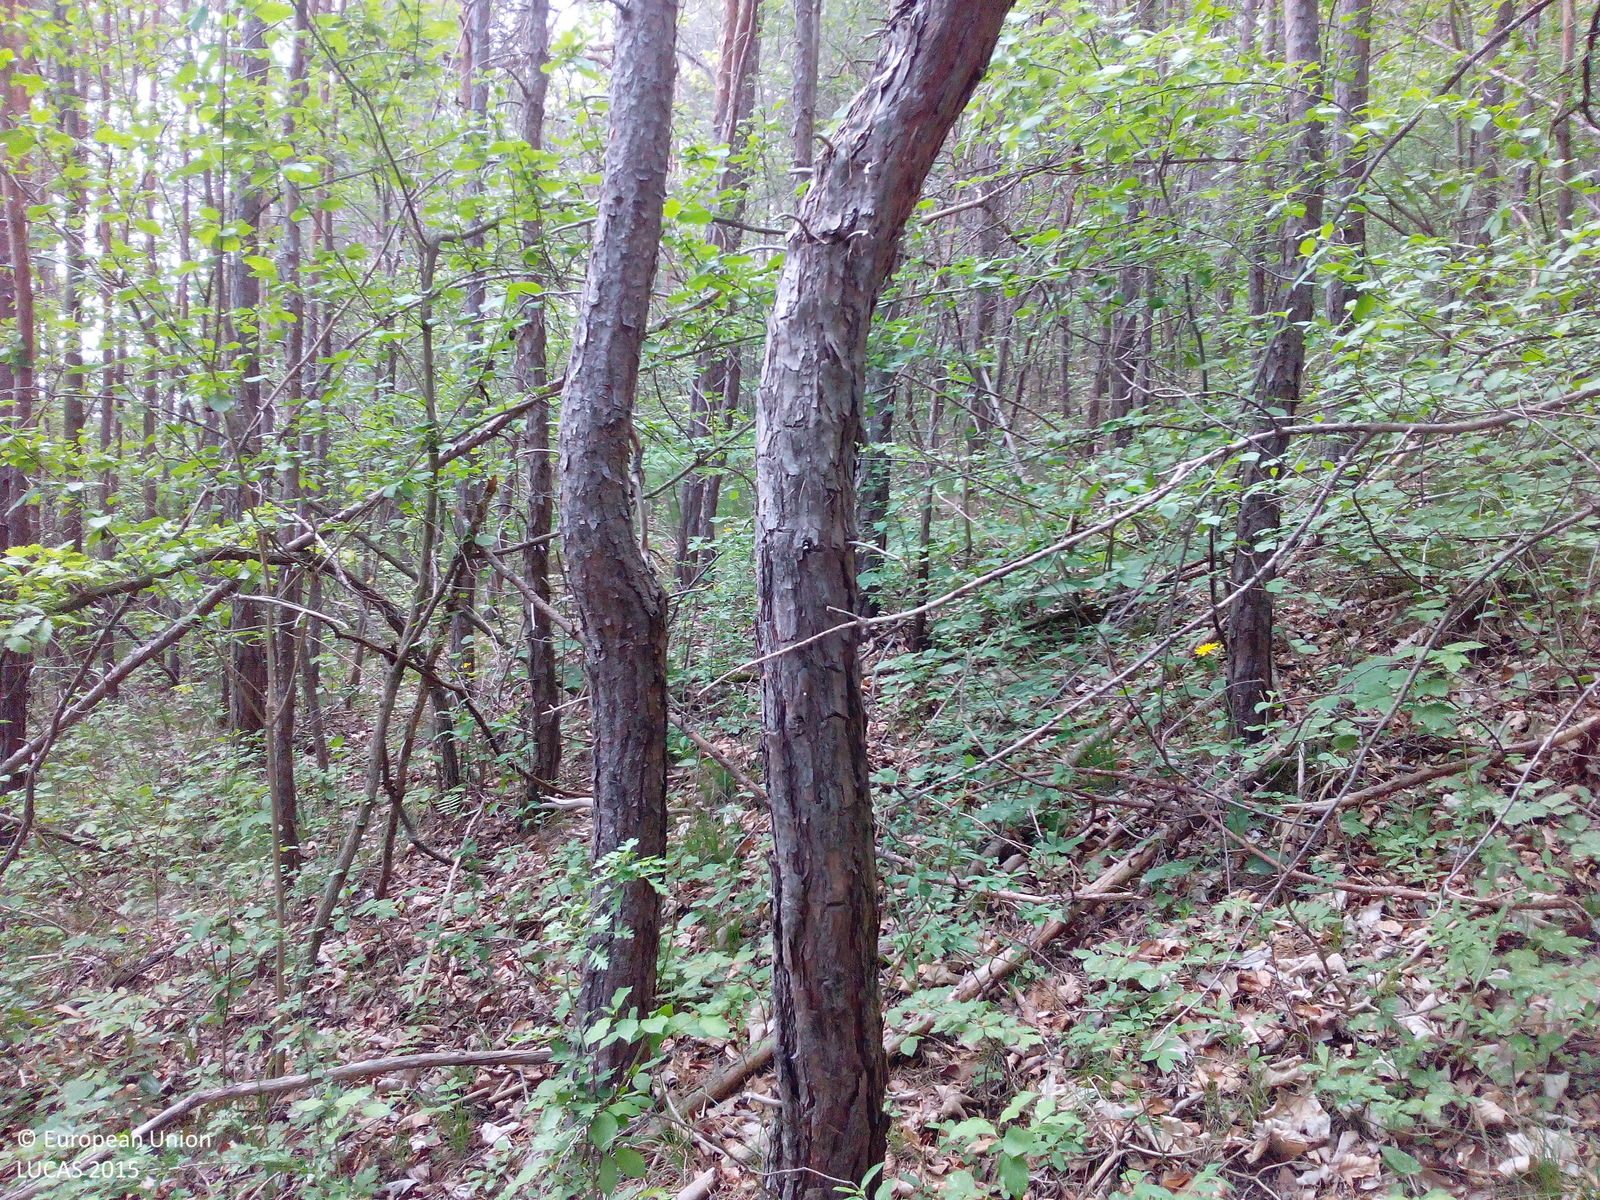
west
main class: Woodland
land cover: Pine dominated mixed woodland
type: hemiboreal forest and nemoral coniferous forest and mixed broadleaved-coniferous forest
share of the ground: > 75 %
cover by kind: coniferous forest trees 75 %, broadleaved forest trees 25 %
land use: Forestry
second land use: Amenities, museums, leisure
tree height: > 5 m
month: May
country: DE
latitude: 50.9110
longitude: 11.5499
